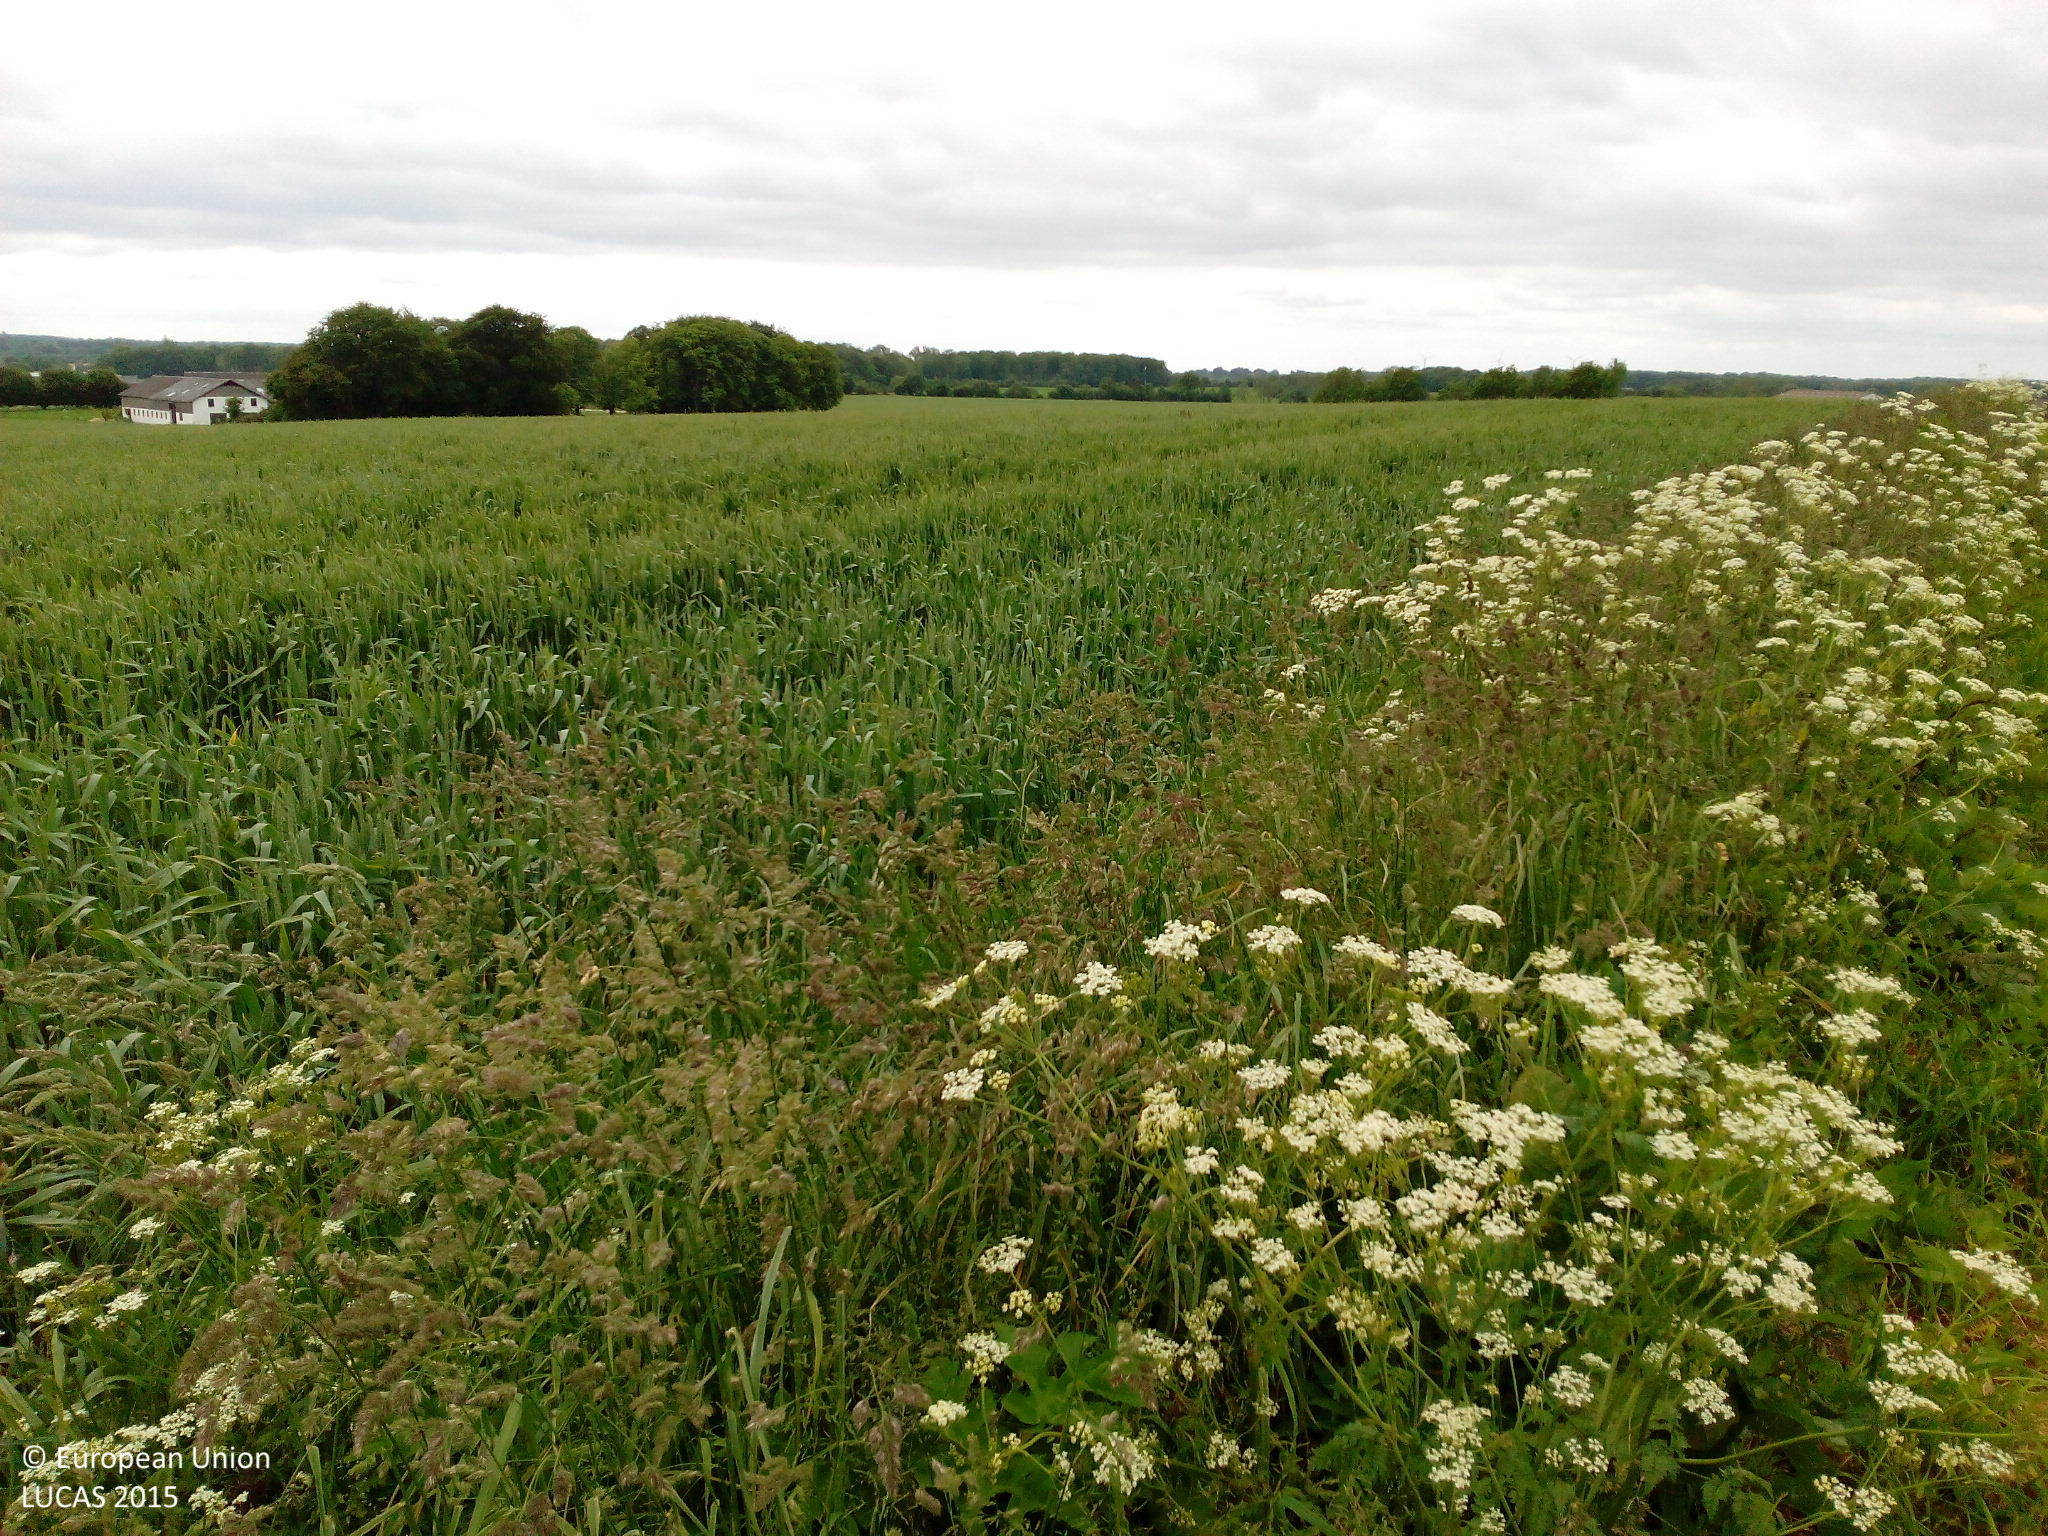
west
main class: Cropland
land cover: Common wheat
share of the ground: > 75 %
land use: Agriculture (excluding fallow land and kitchen gardens)
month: June
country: DK
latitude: 55.1794
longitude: 10.6747
